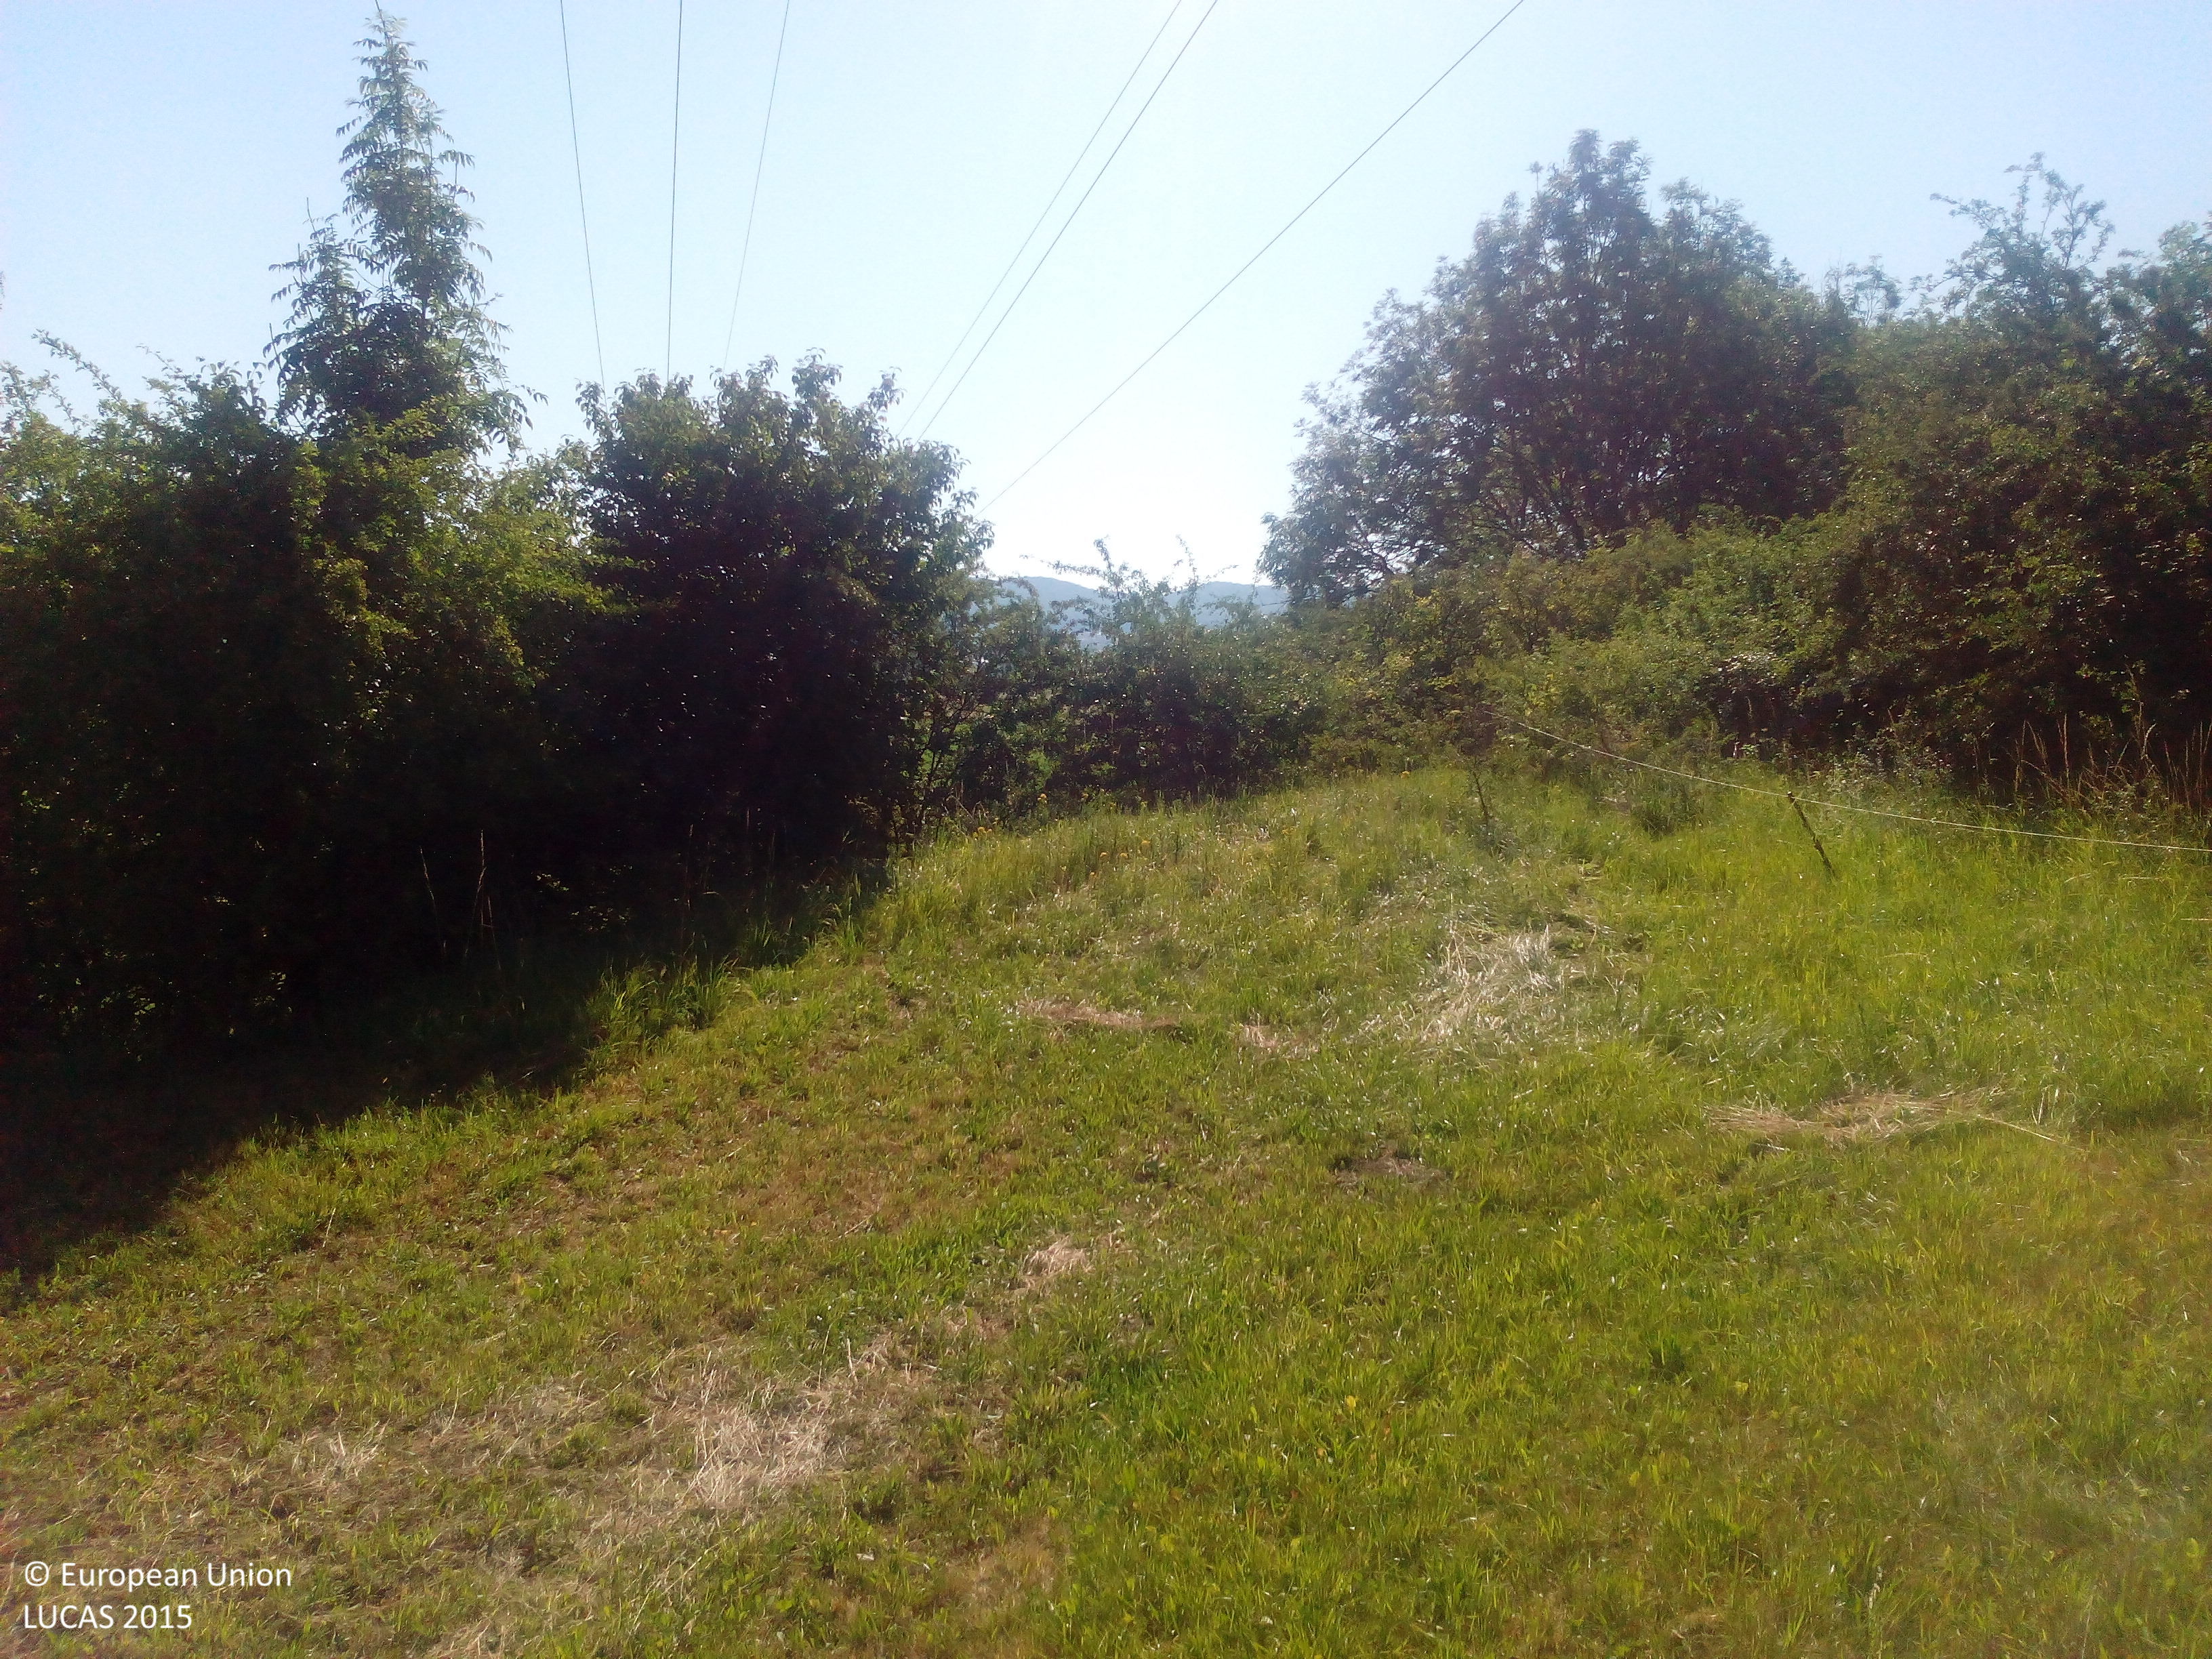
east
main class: Artificial land
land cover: Other artificial areas
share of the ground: > 75 %
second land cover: Grassland with sparse tree/shrub cover
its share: > 75 %
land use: Electricity, gas and thermal power distribution
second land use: Agriculture (excluding fallow land and kitchen gardens)
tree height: > 5 m
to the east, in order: Electric lines; Grassland with sparse tree/shrub cover; Abandoned hedges; Grassland without tree/shrub cover; Fences; Ditches and canals; Grass margins; Sugar beet
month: July
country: DE
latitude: 51.6944
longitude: 9.9566
